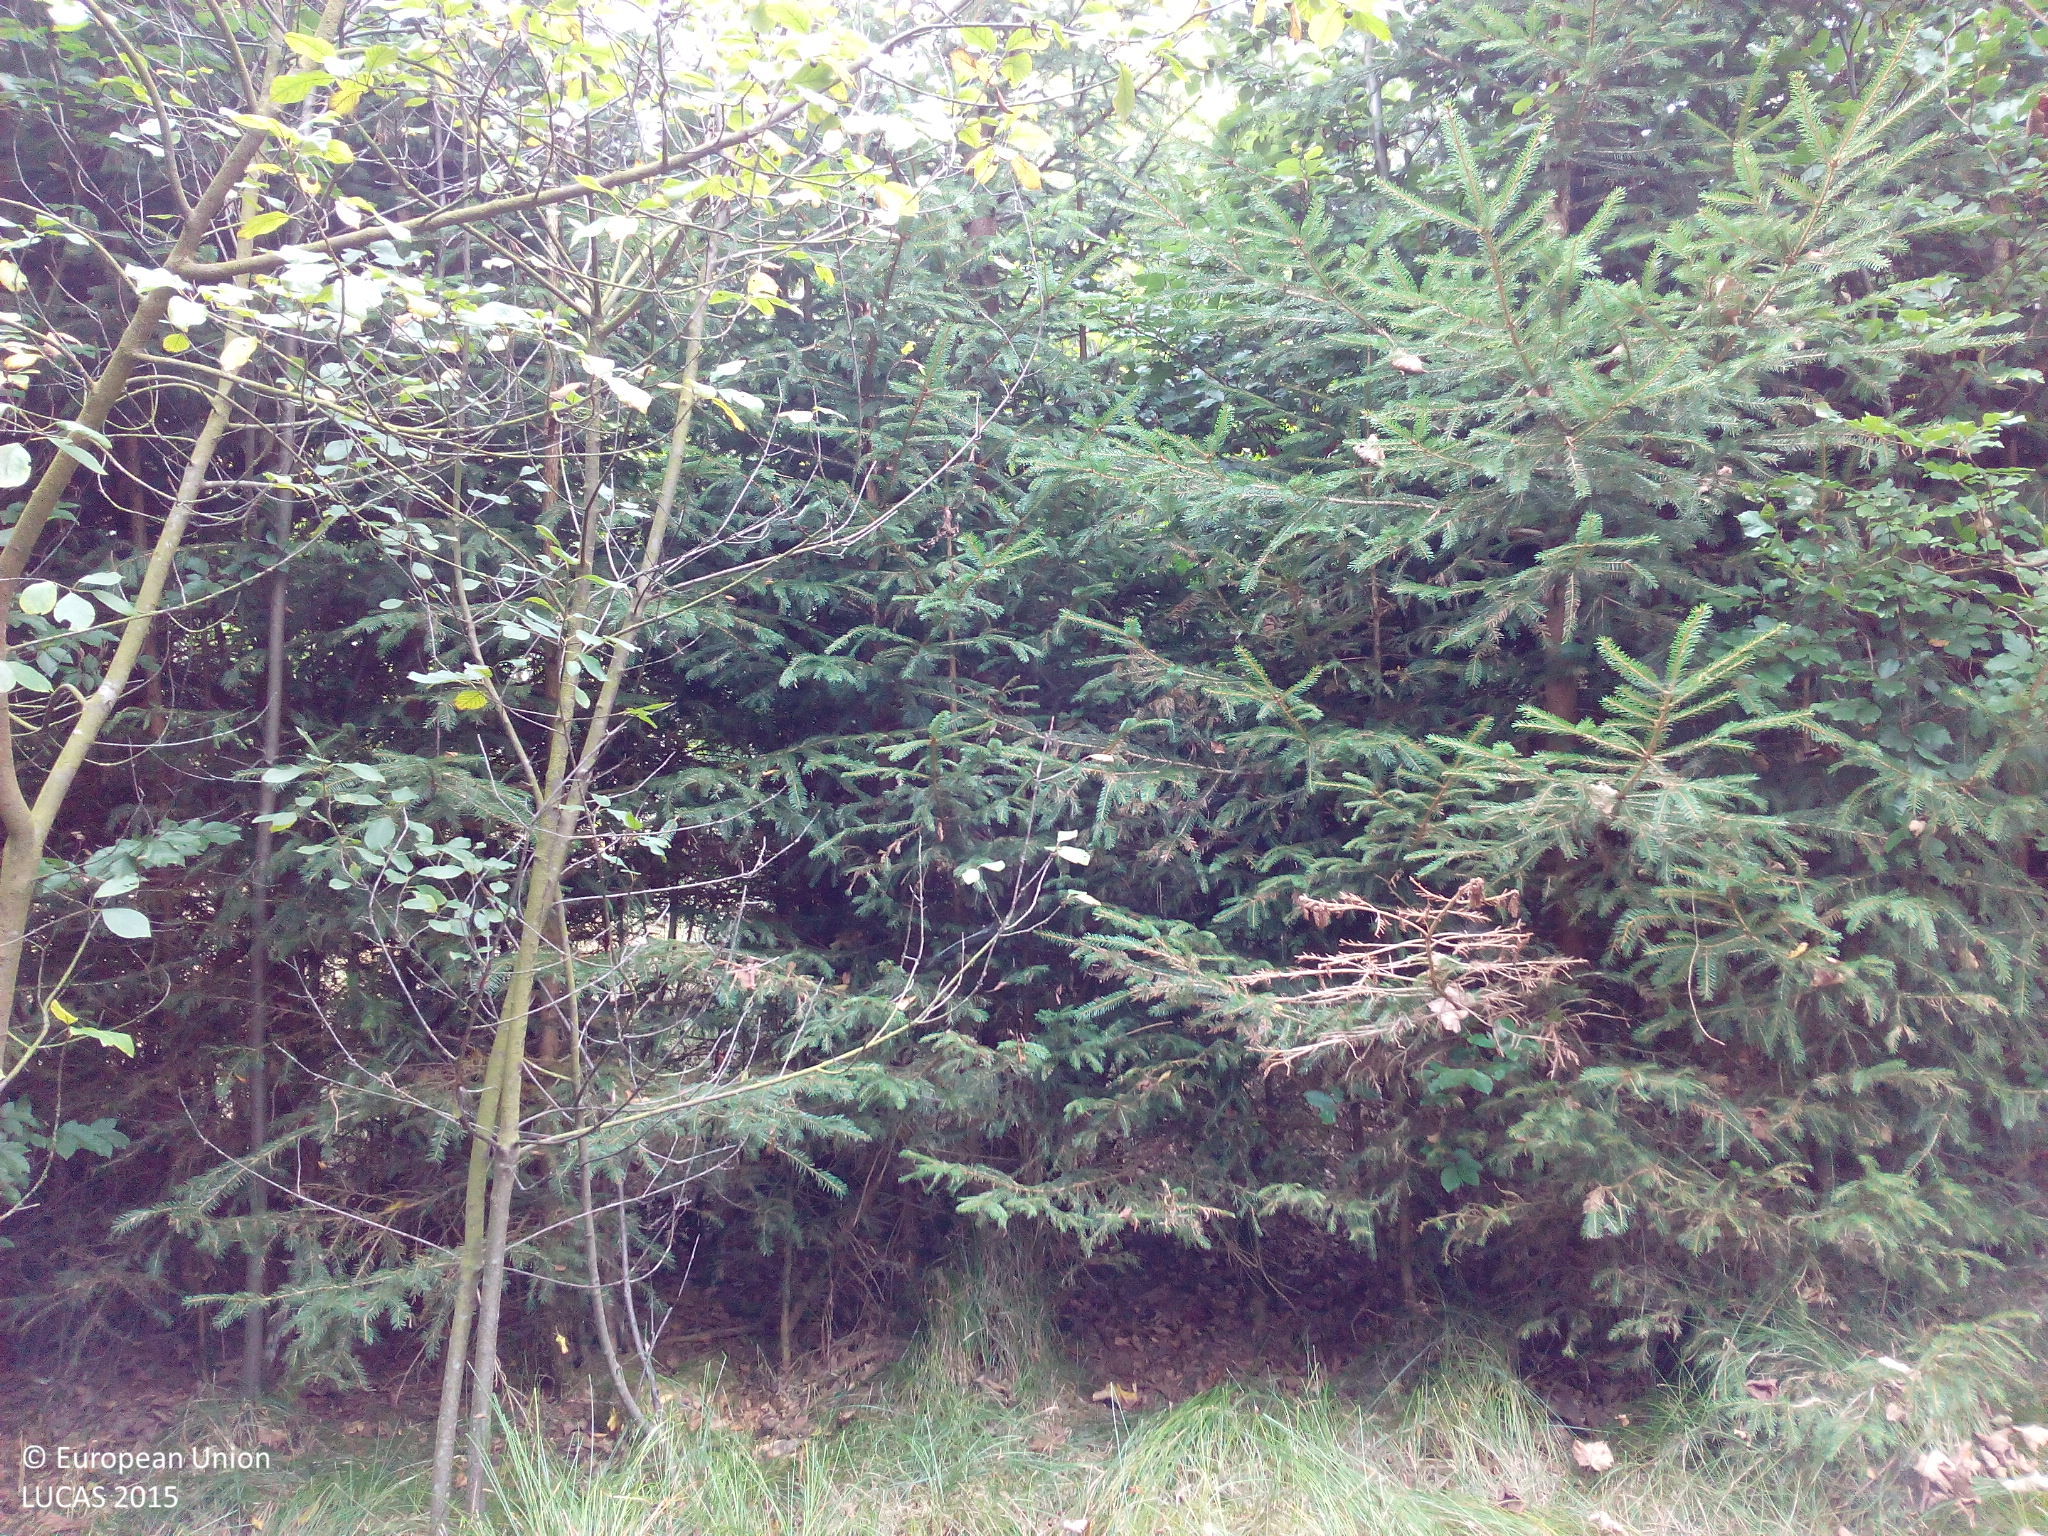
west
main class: Woodland
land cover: Broadleaved woodland
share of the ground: 50 - 75 %
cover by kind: broadleaved forest trees 60 %, herbaceous plants 40 %
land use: Forestry
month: September
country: DE
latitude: 48.3312
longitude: 10.2561
